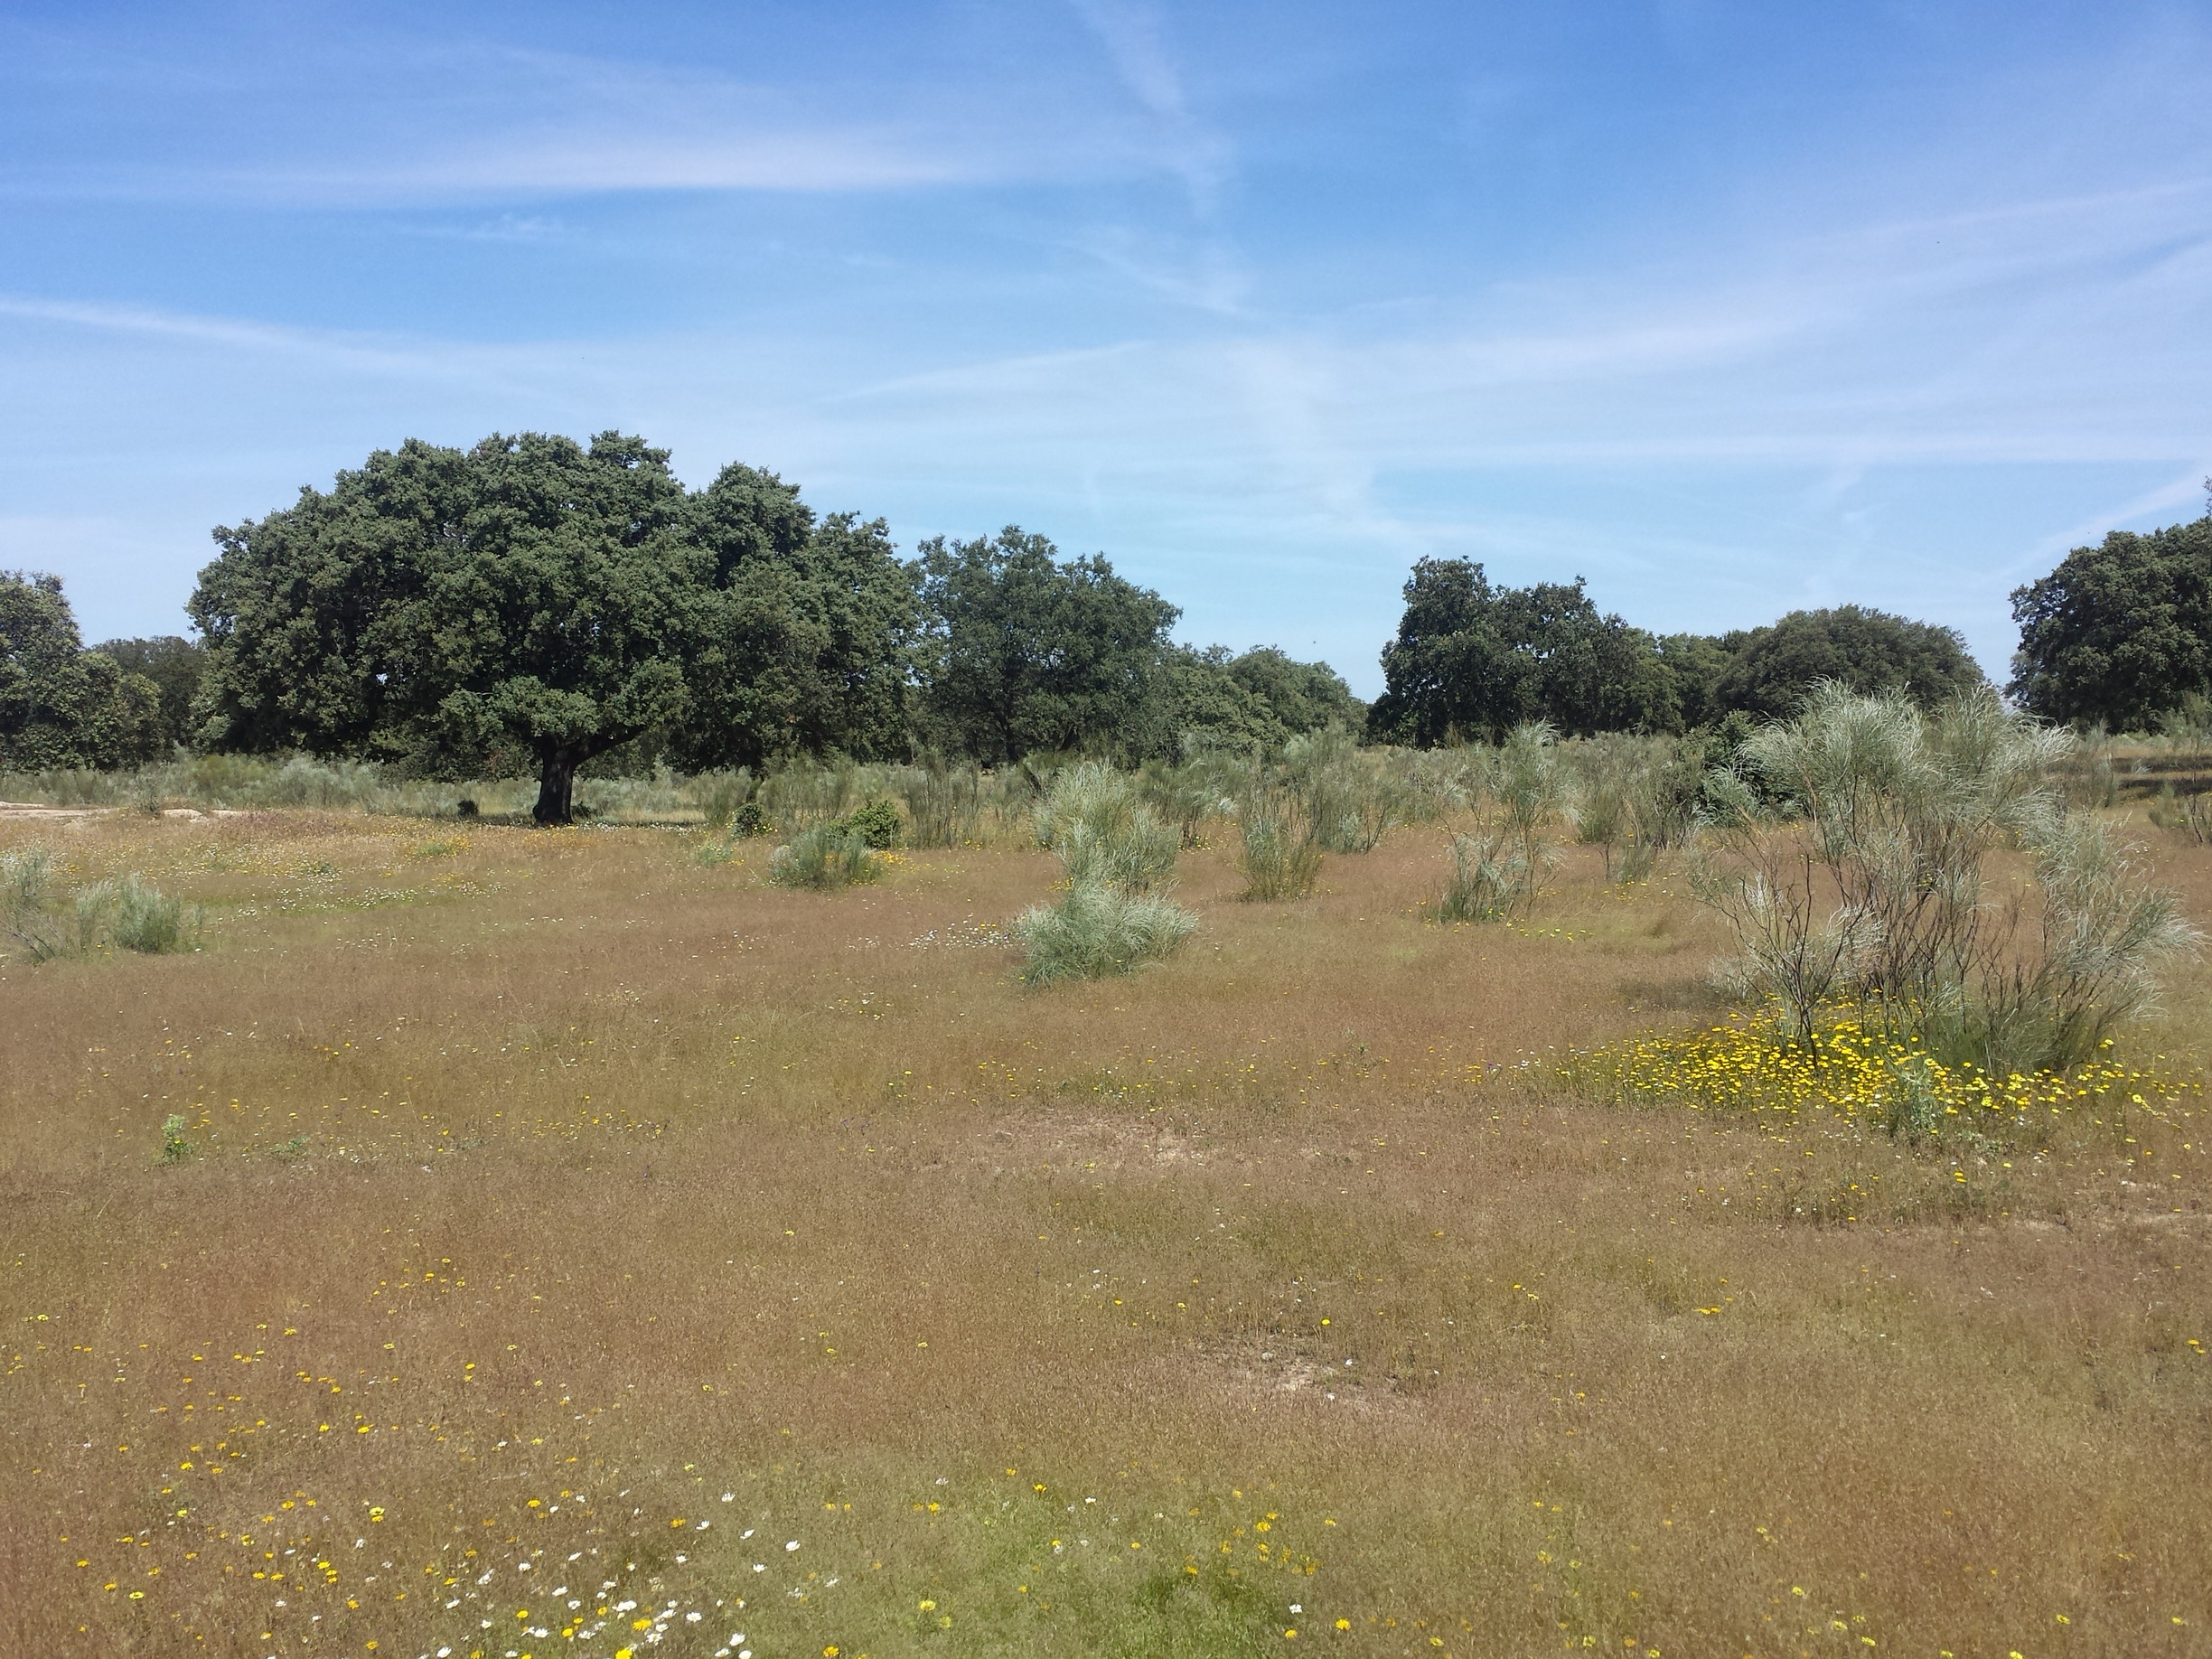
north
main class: Woodland
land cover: Broadleaved woodland
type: broadleaved evergreen forest
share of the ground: 10 - 25 %
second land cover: Grassland without tree/shrub cover
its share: > 75 %
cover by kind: herbaceous plants 85 %, broadleaved forest trees 15 %
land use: Forestry
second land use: Agriculture (excluding fallow land and kitchen gardens)
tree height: > 5 m
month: May
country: ES
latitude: 39.5667
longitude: -7.0911
